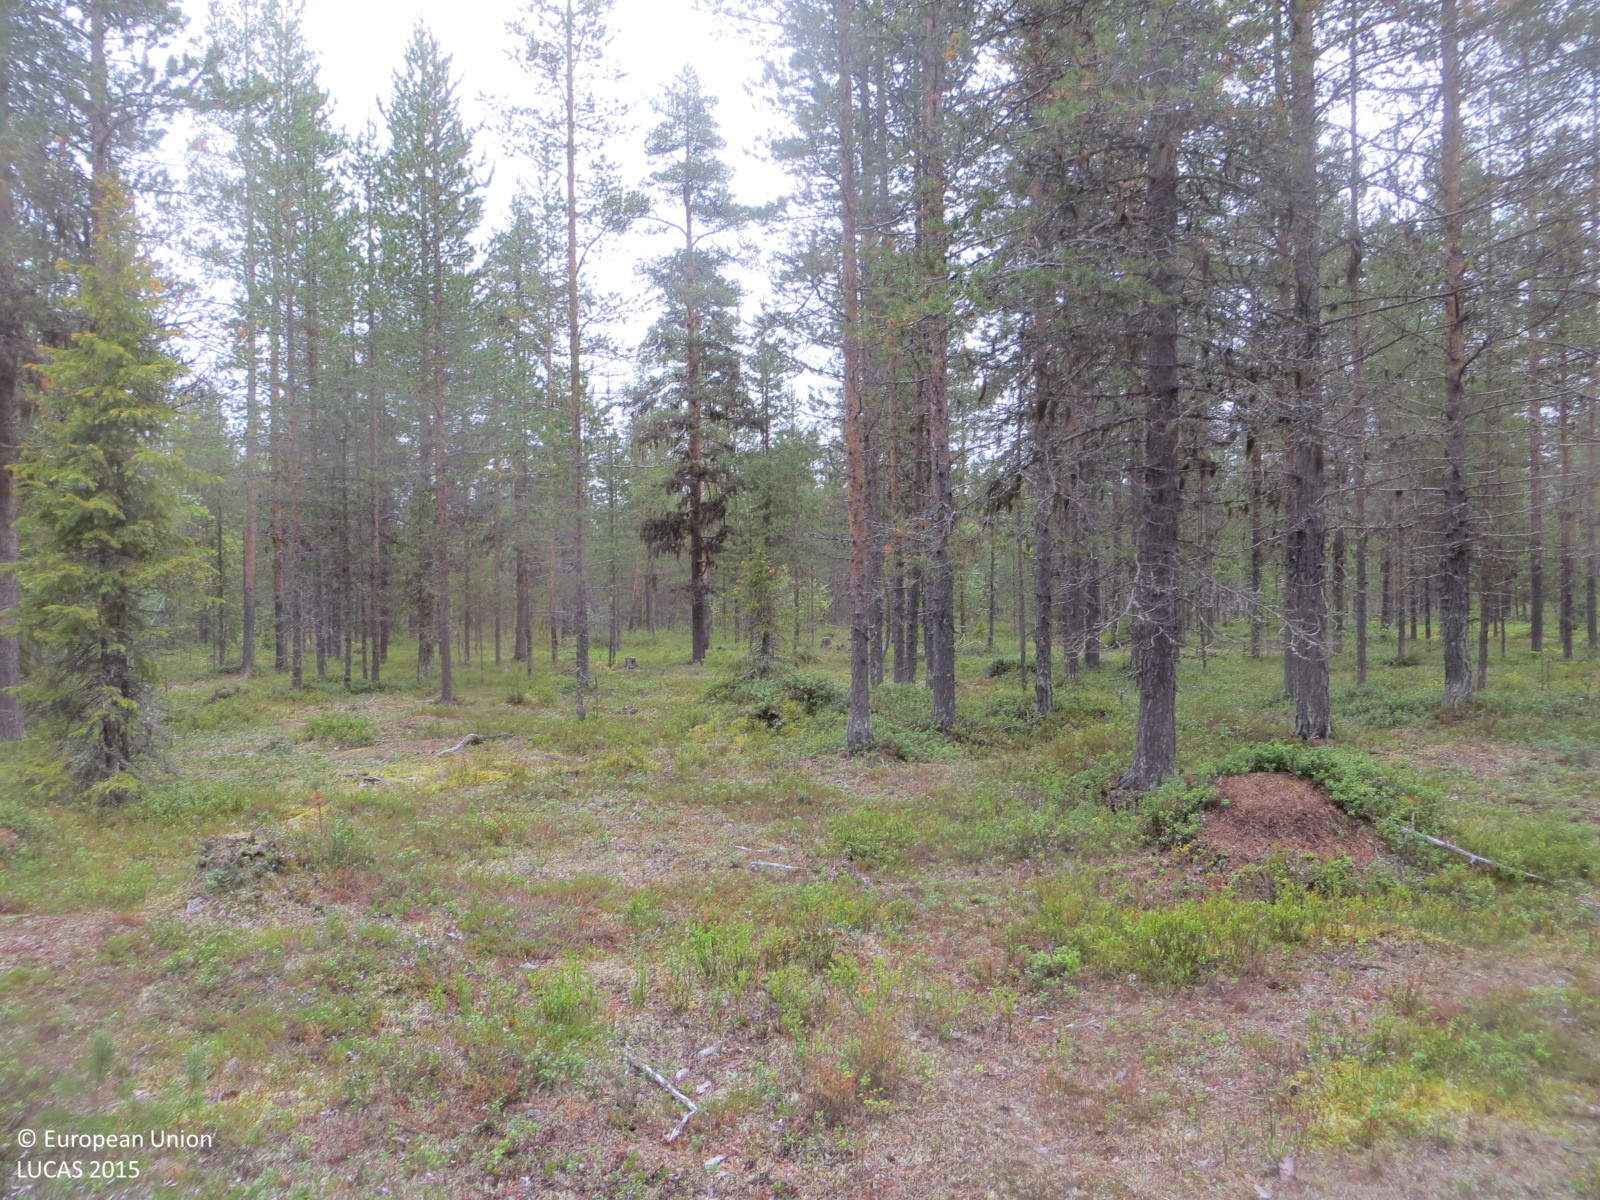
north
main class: Woodland
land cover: Pine dominated coniferous woodland
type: boreal forest
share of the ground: 50 - 75 %
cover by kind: coniferous forest trees 50 %, shrubs 50 %
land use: Forestry
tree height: > 5 m
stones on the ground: > 50 %
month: August
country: FI
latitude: 67.4132
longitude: 24.1416
